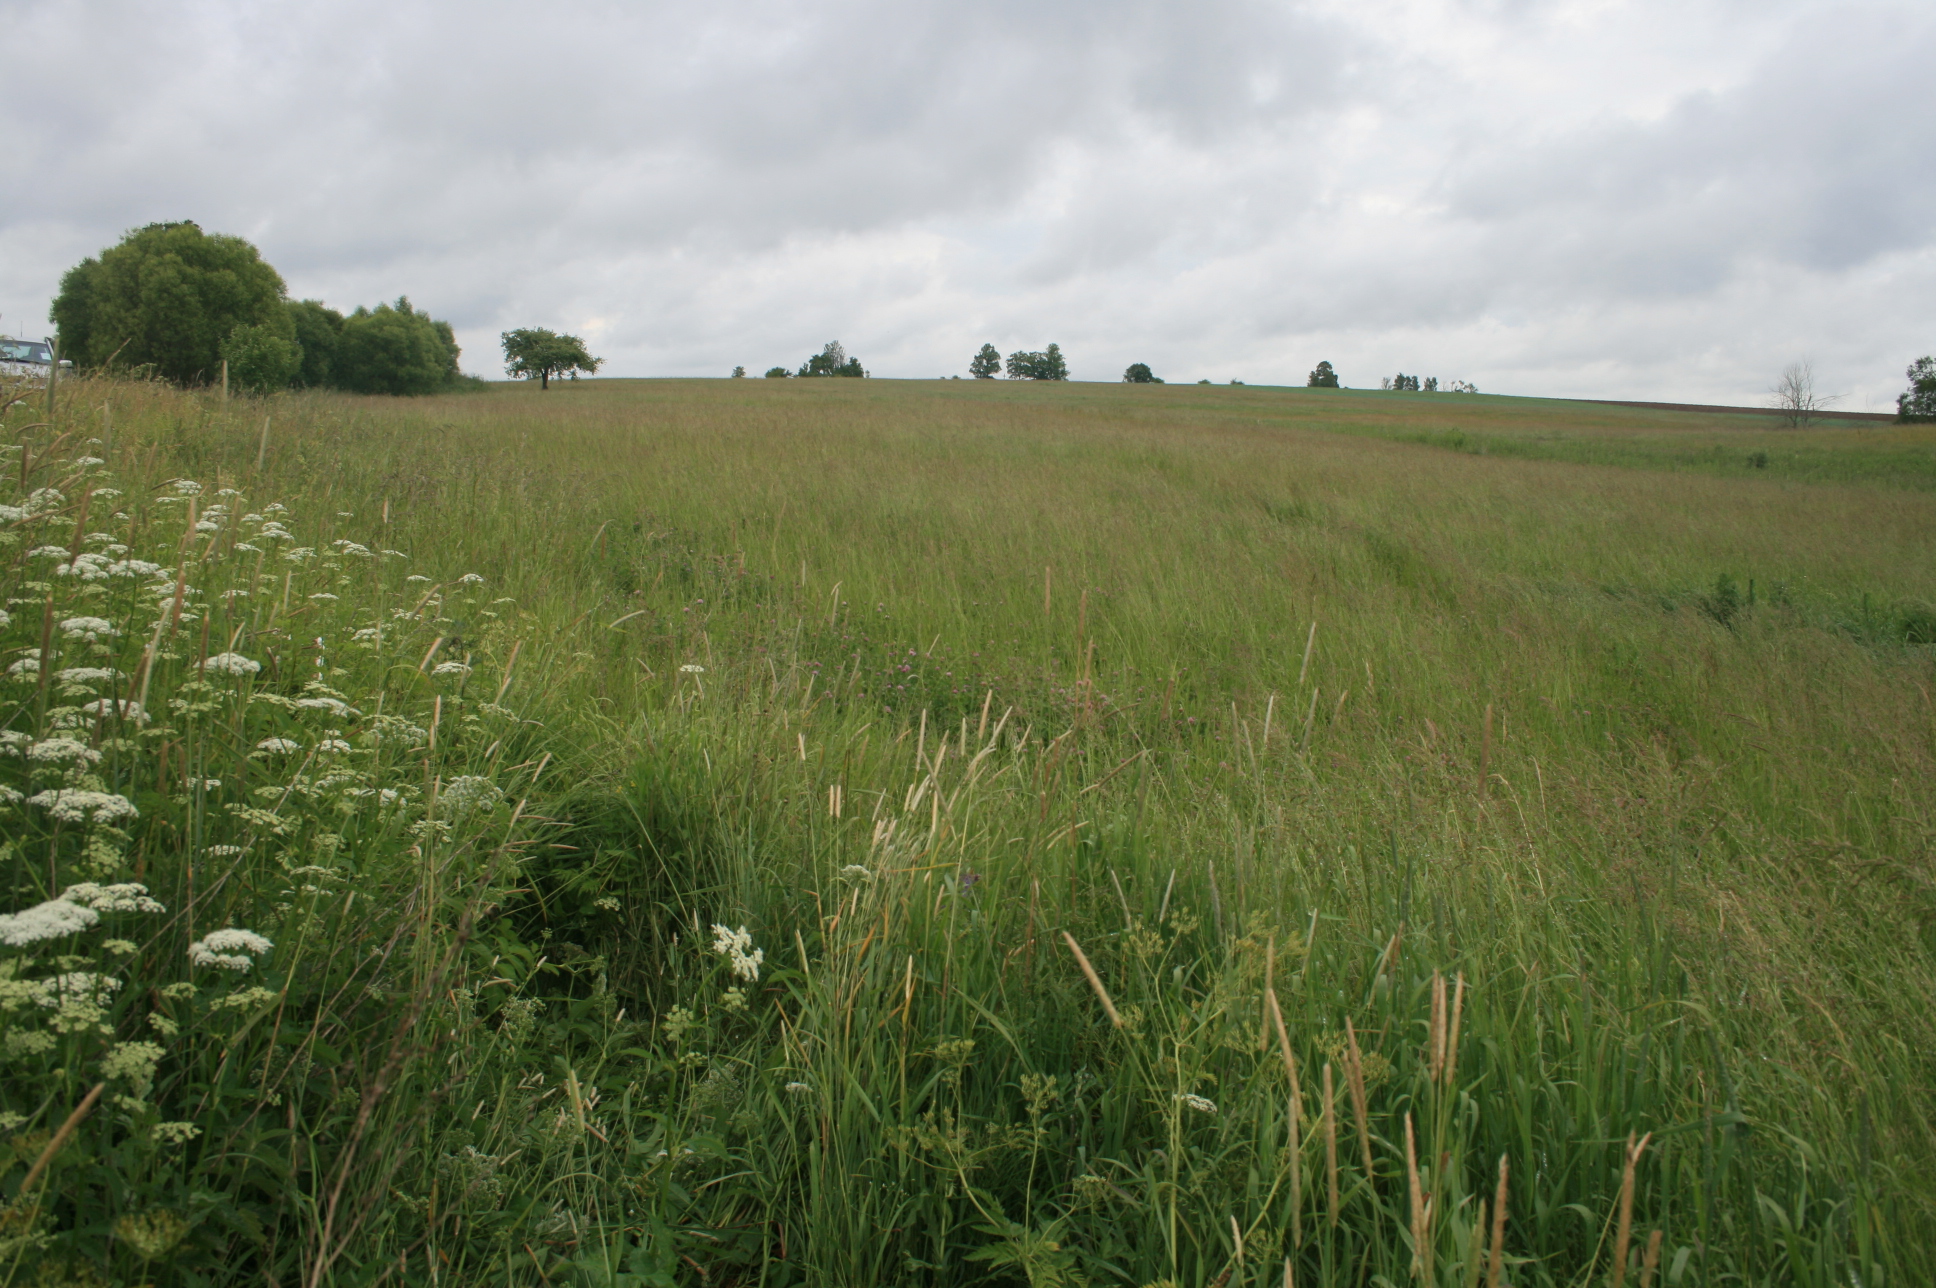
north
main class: Grassland
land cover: Grassland without tree/shrub cover
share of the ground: > 75 %
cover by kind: herbaceous plants 100 %
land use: Agriculture (excluding fallow land and kitchen gardens)
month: June
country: LT
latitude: 55.2161
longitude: 22.4306
